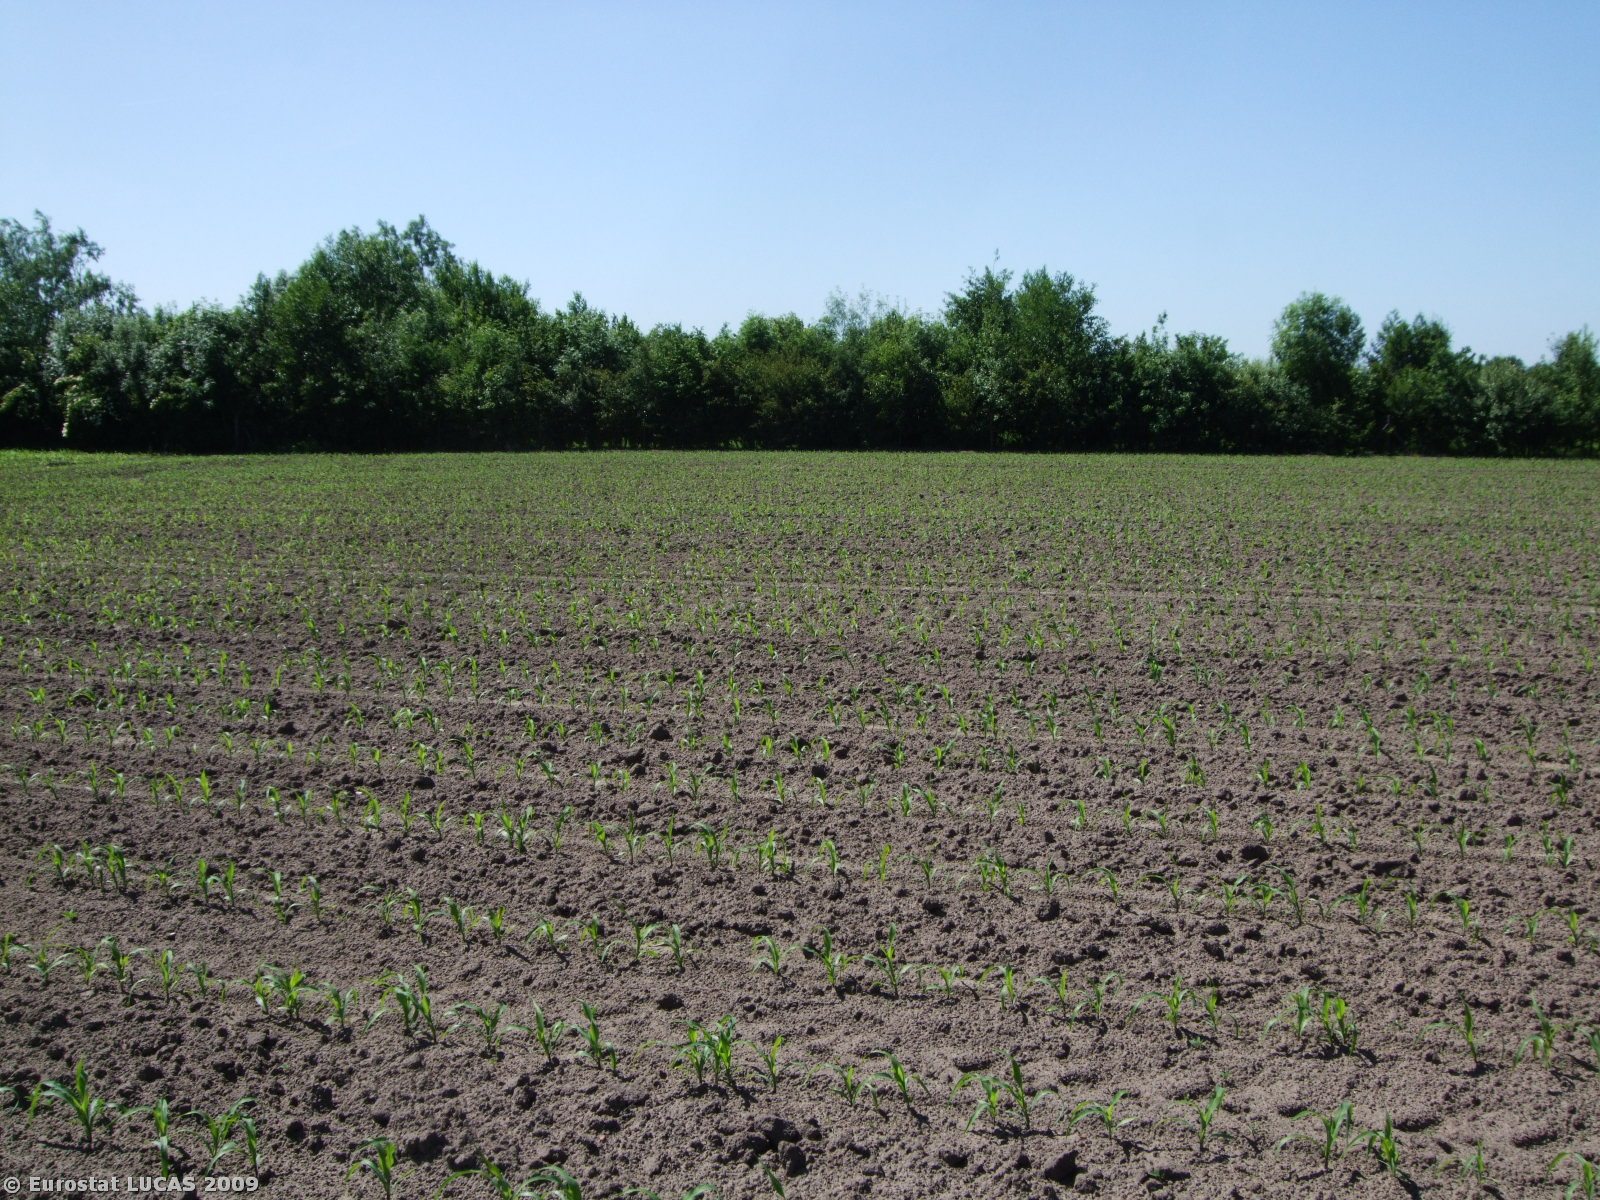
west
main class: Cropland
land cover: Maize
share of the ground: 25 - 50 %
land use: Agriculture (excluding fallow land and kitchen gardens)
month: June
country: NL
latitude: 51.5669
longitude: 5.3670
